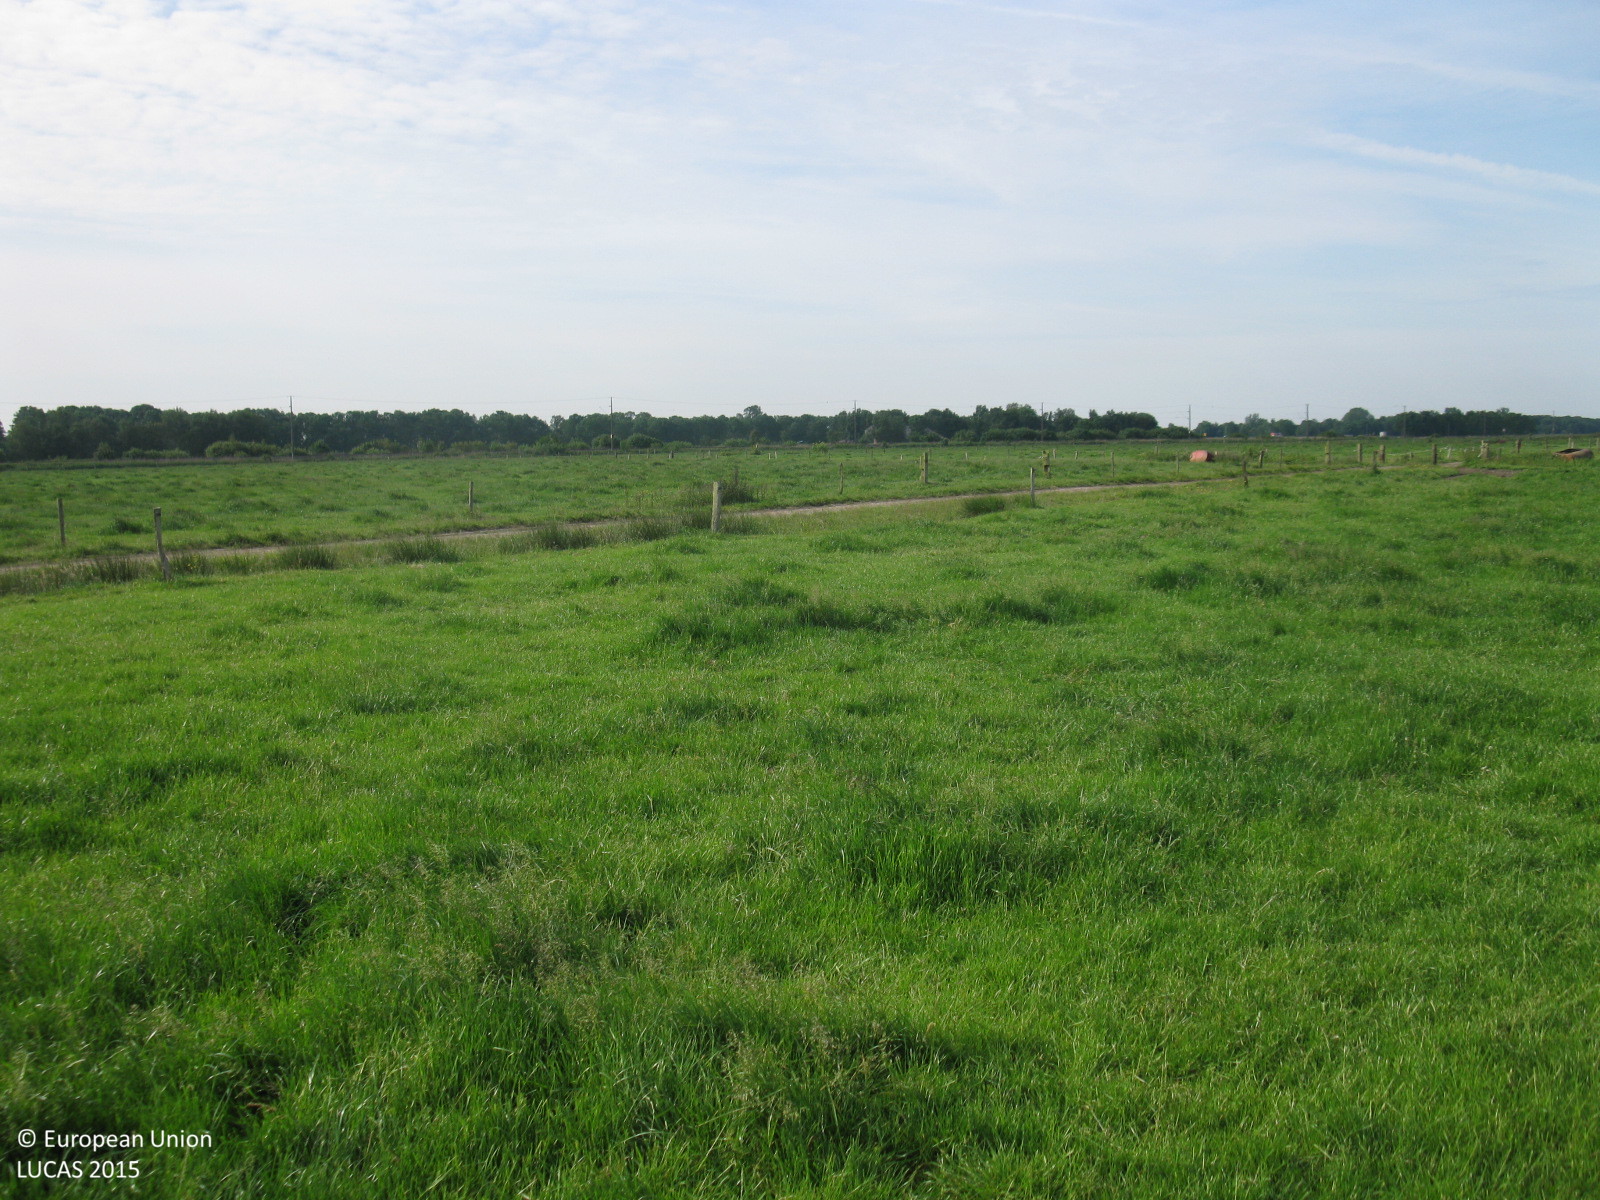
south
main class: Grassland
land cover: Grassland without tree/shrub cover
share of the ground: > 75 %
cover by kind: herbaceous plants 100 %
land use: Agriculture (excluding fallow land and kitchen gardens)
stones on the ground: < 10 %
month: June
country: DE
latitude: 53.4612
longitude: 7.2745
